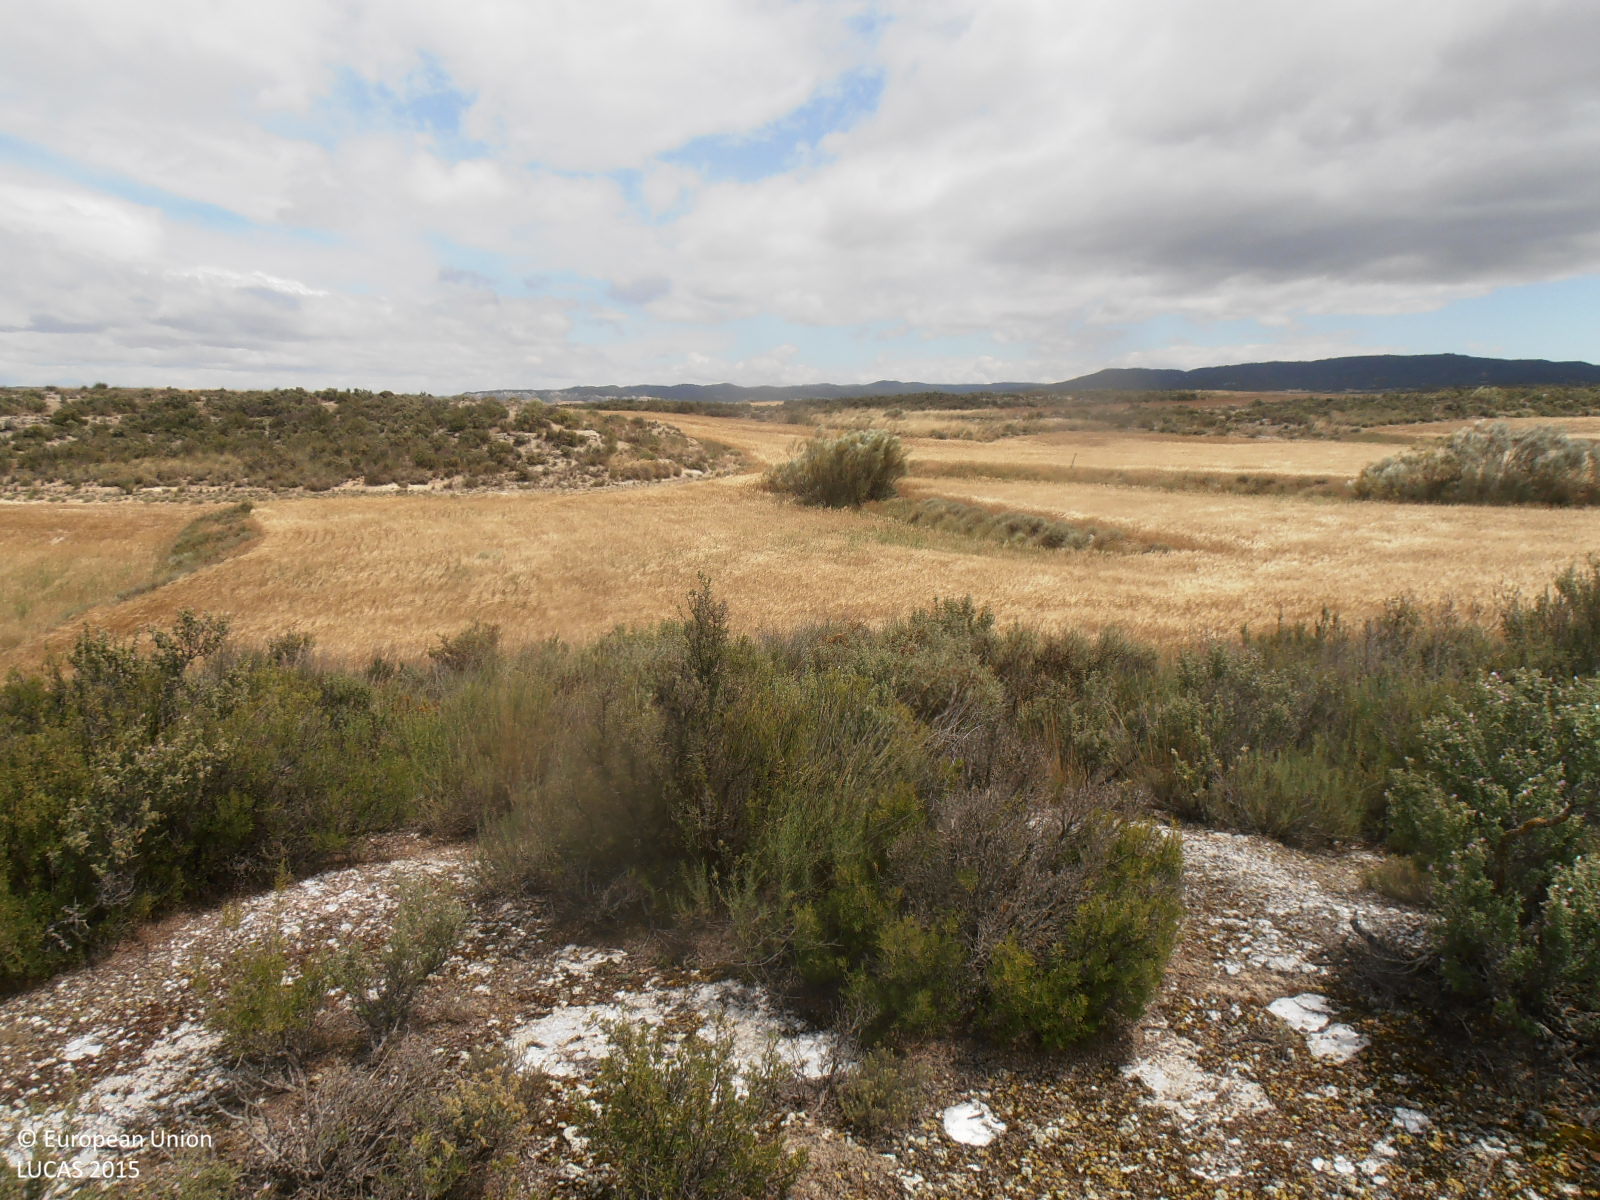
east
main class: Shrubland
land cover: Shrubland without tree cover
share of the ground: 50 - 75 %
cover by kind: shrubs 60 %, consolidated bare surface 40 %
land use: Semi-natural and natural areas not in use
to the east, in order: Shrubland without tree cover; Common wheat; Shruby margins; Common wheat; Shruby margins; Common wheat; Shrubland without tree cover; Durum wheat; Shrubland without tree cover
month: June
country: ES
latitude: 41.9317
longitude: -1.1092
